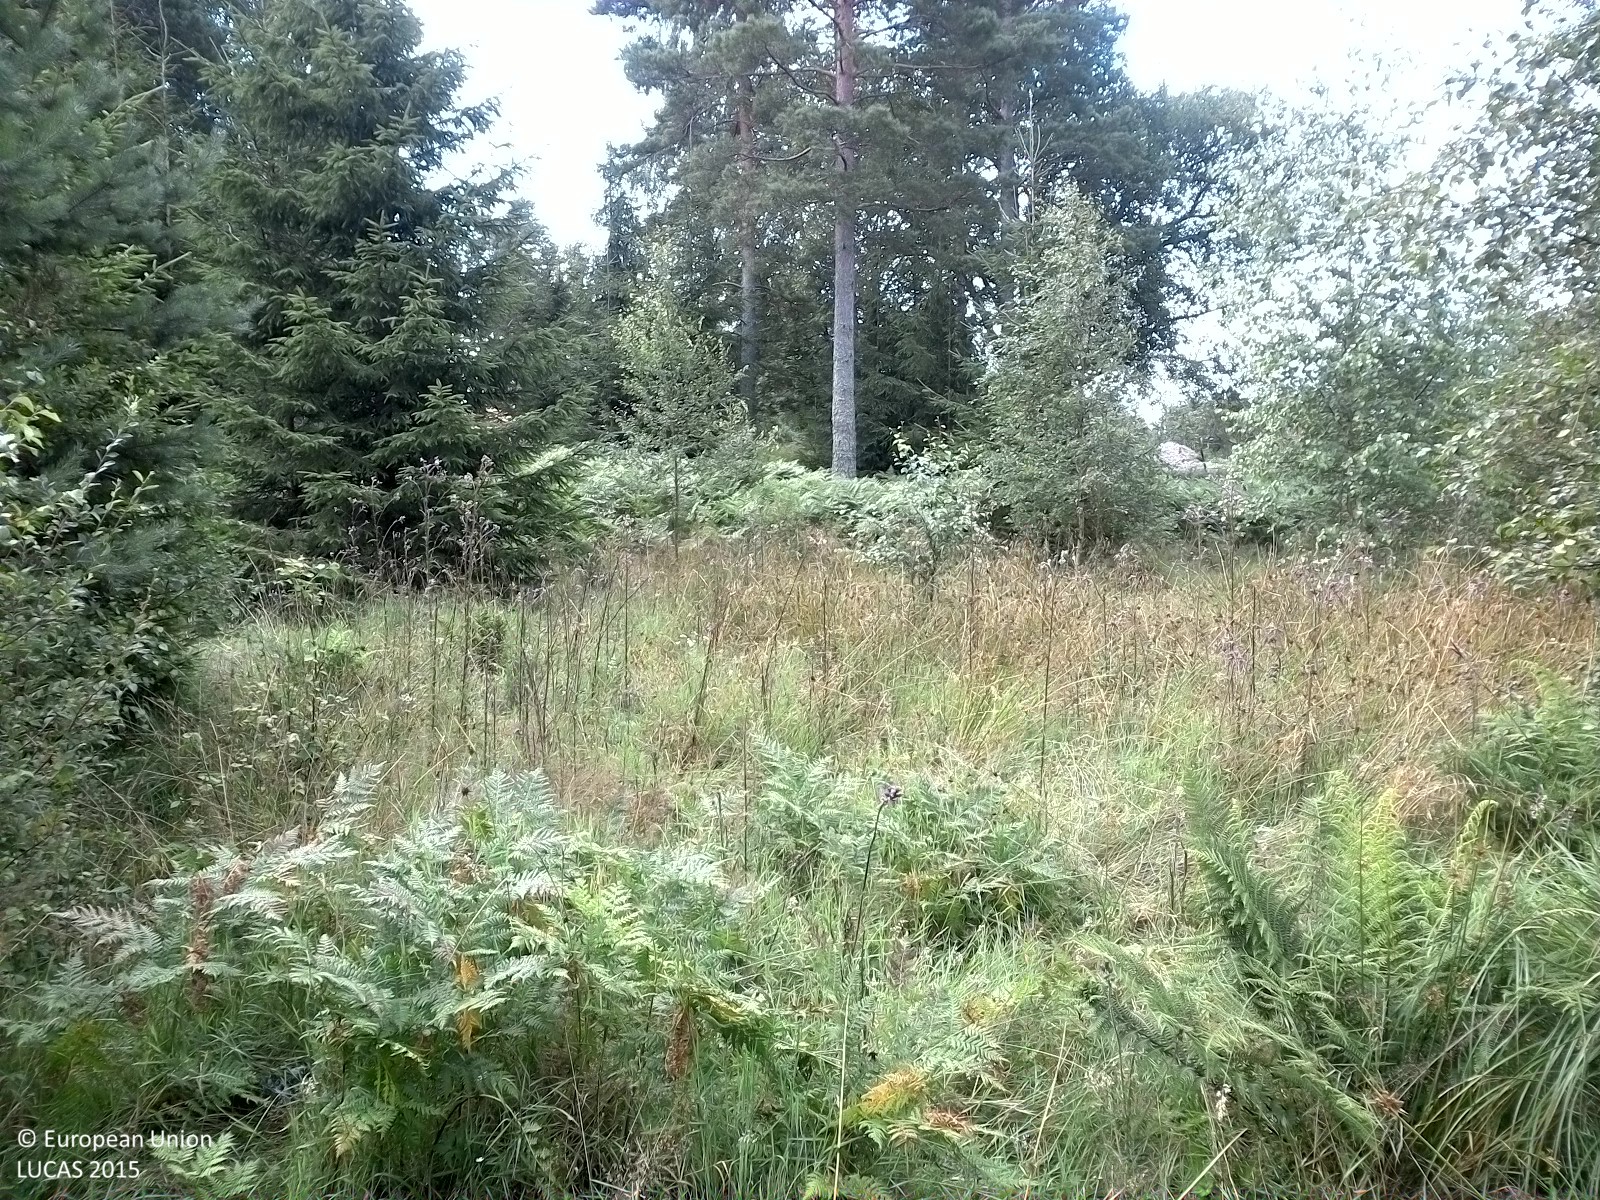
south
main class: Woodland
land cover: Other mixed woodland
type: hemiboreal forest and nemoral coniferous forest and mixed broadleaved-coniferous forest
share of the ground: 25 - 50 %
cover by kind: herbaceous plants 70 %, coniferous forest trees 15 %, broadleaved forest trees 15 %
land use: Forestry
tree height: < 5 m
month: August
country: SE
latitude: 58.8883
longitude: 15.3544
